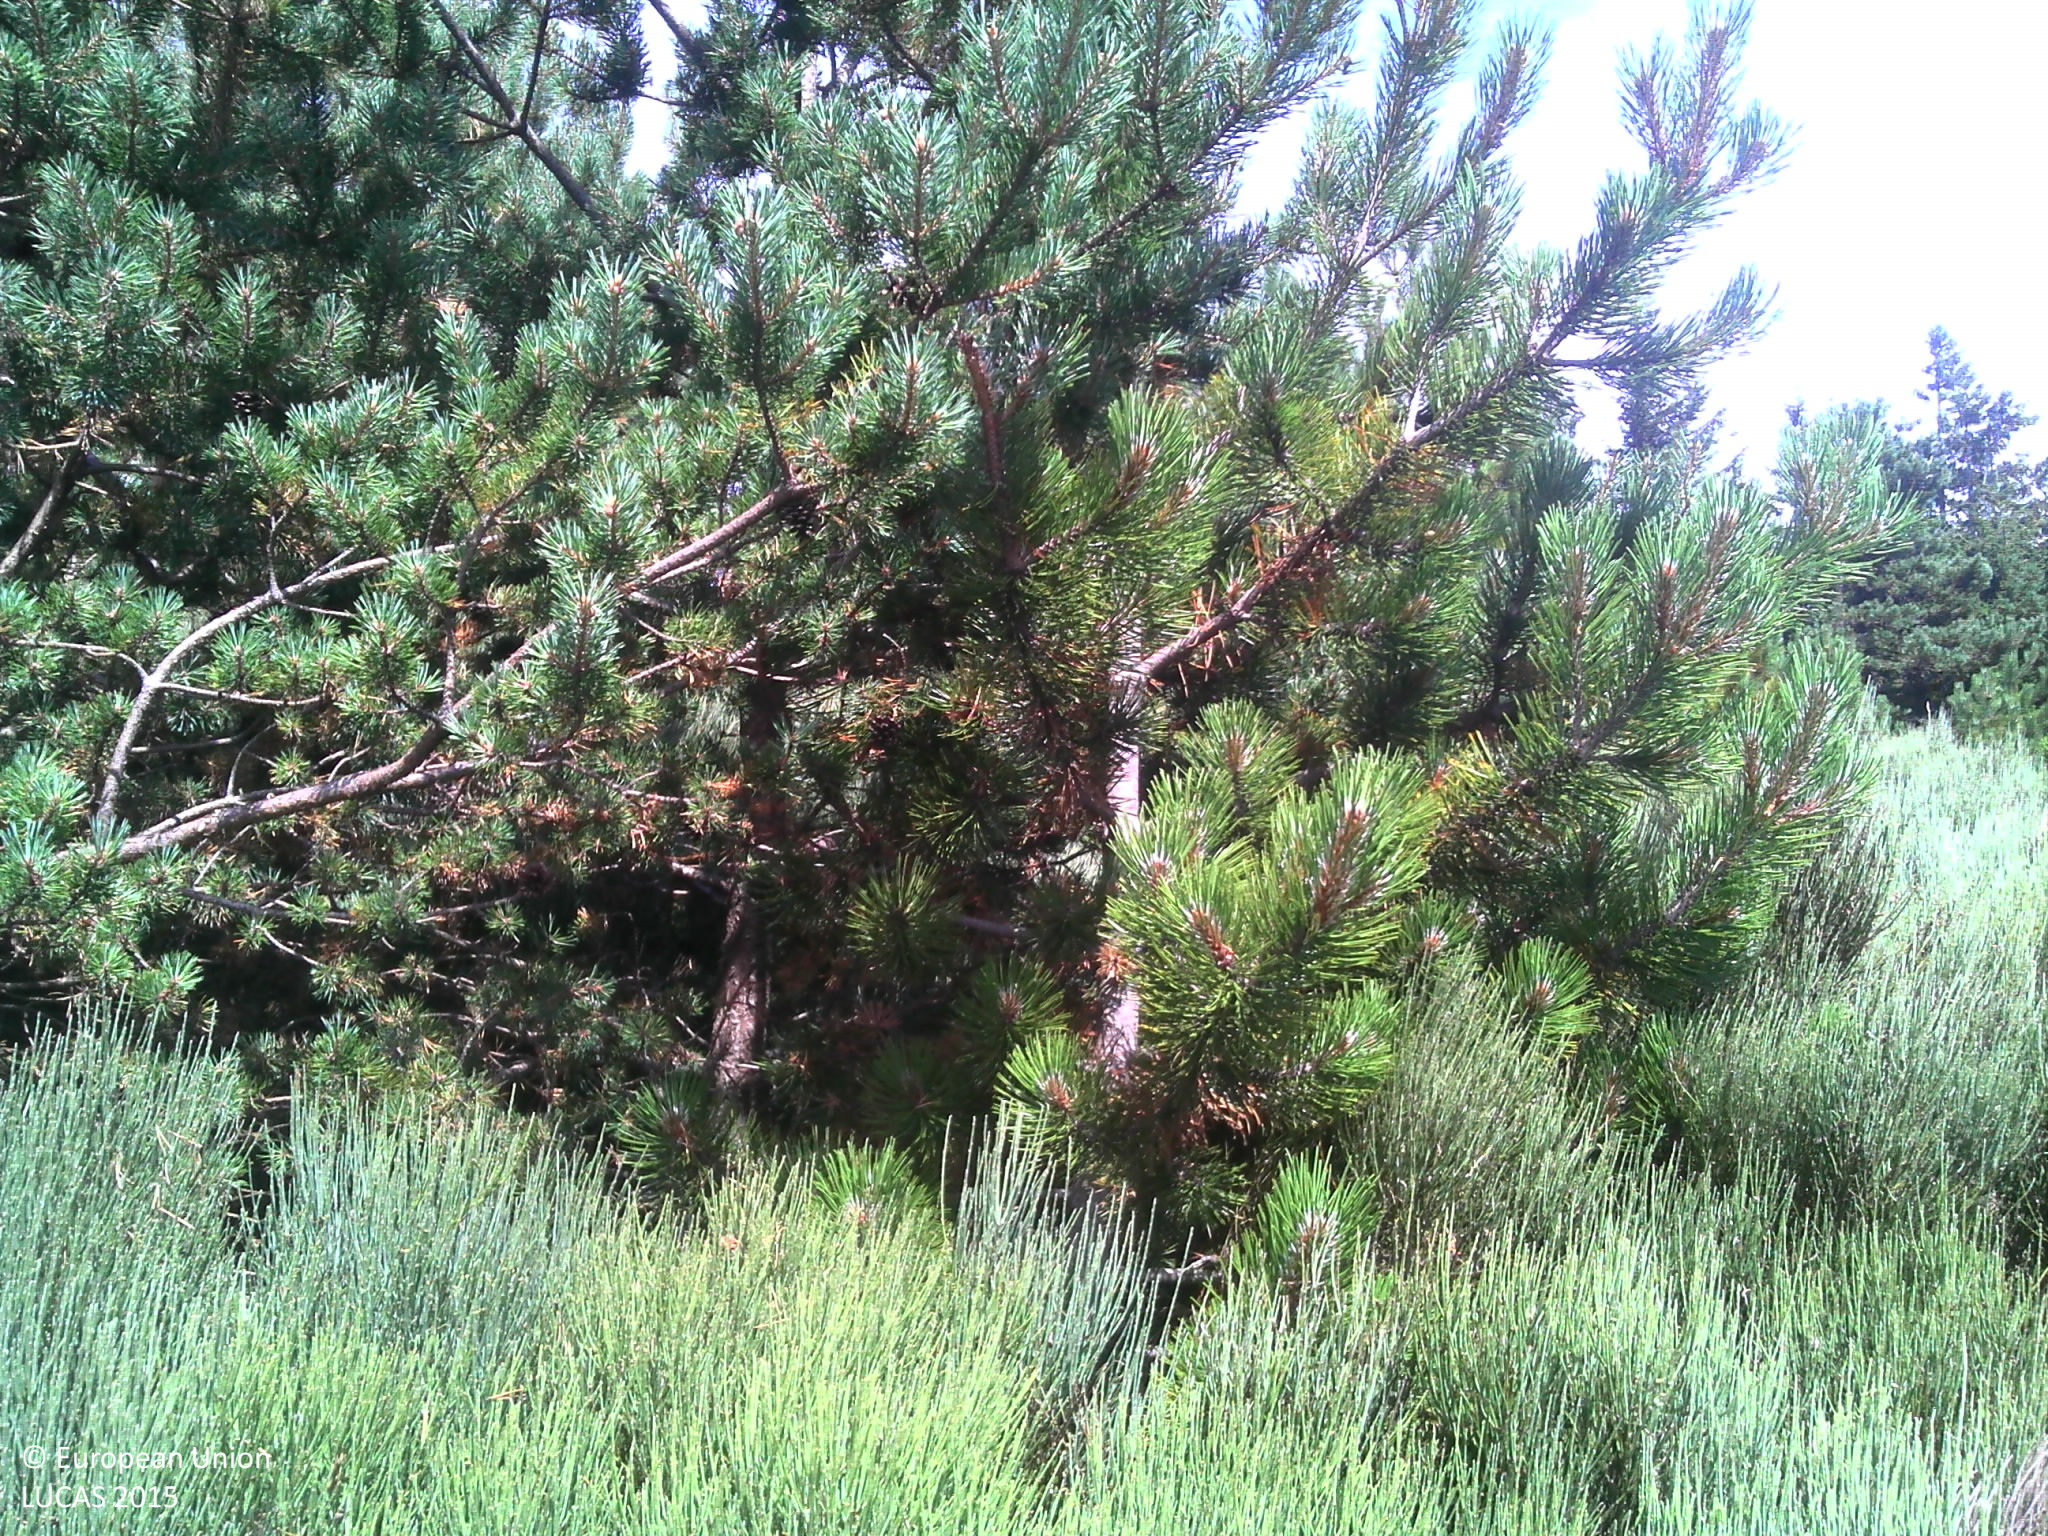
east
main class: Shrubland
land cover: Shrubland with sparse tree cover
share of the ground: > 75 %
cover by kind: shrubs 95 %, coniferous forest trees 5 %
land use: Semi-natural and natural areas not in use
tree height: < 5 m
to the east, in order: Shrubland with sparse tree cover; Pine dominated coniferous woodland; Tracks; Pine dominated coniferous woodland
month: July
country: FR
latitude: 44.6062
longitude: 3.9199
